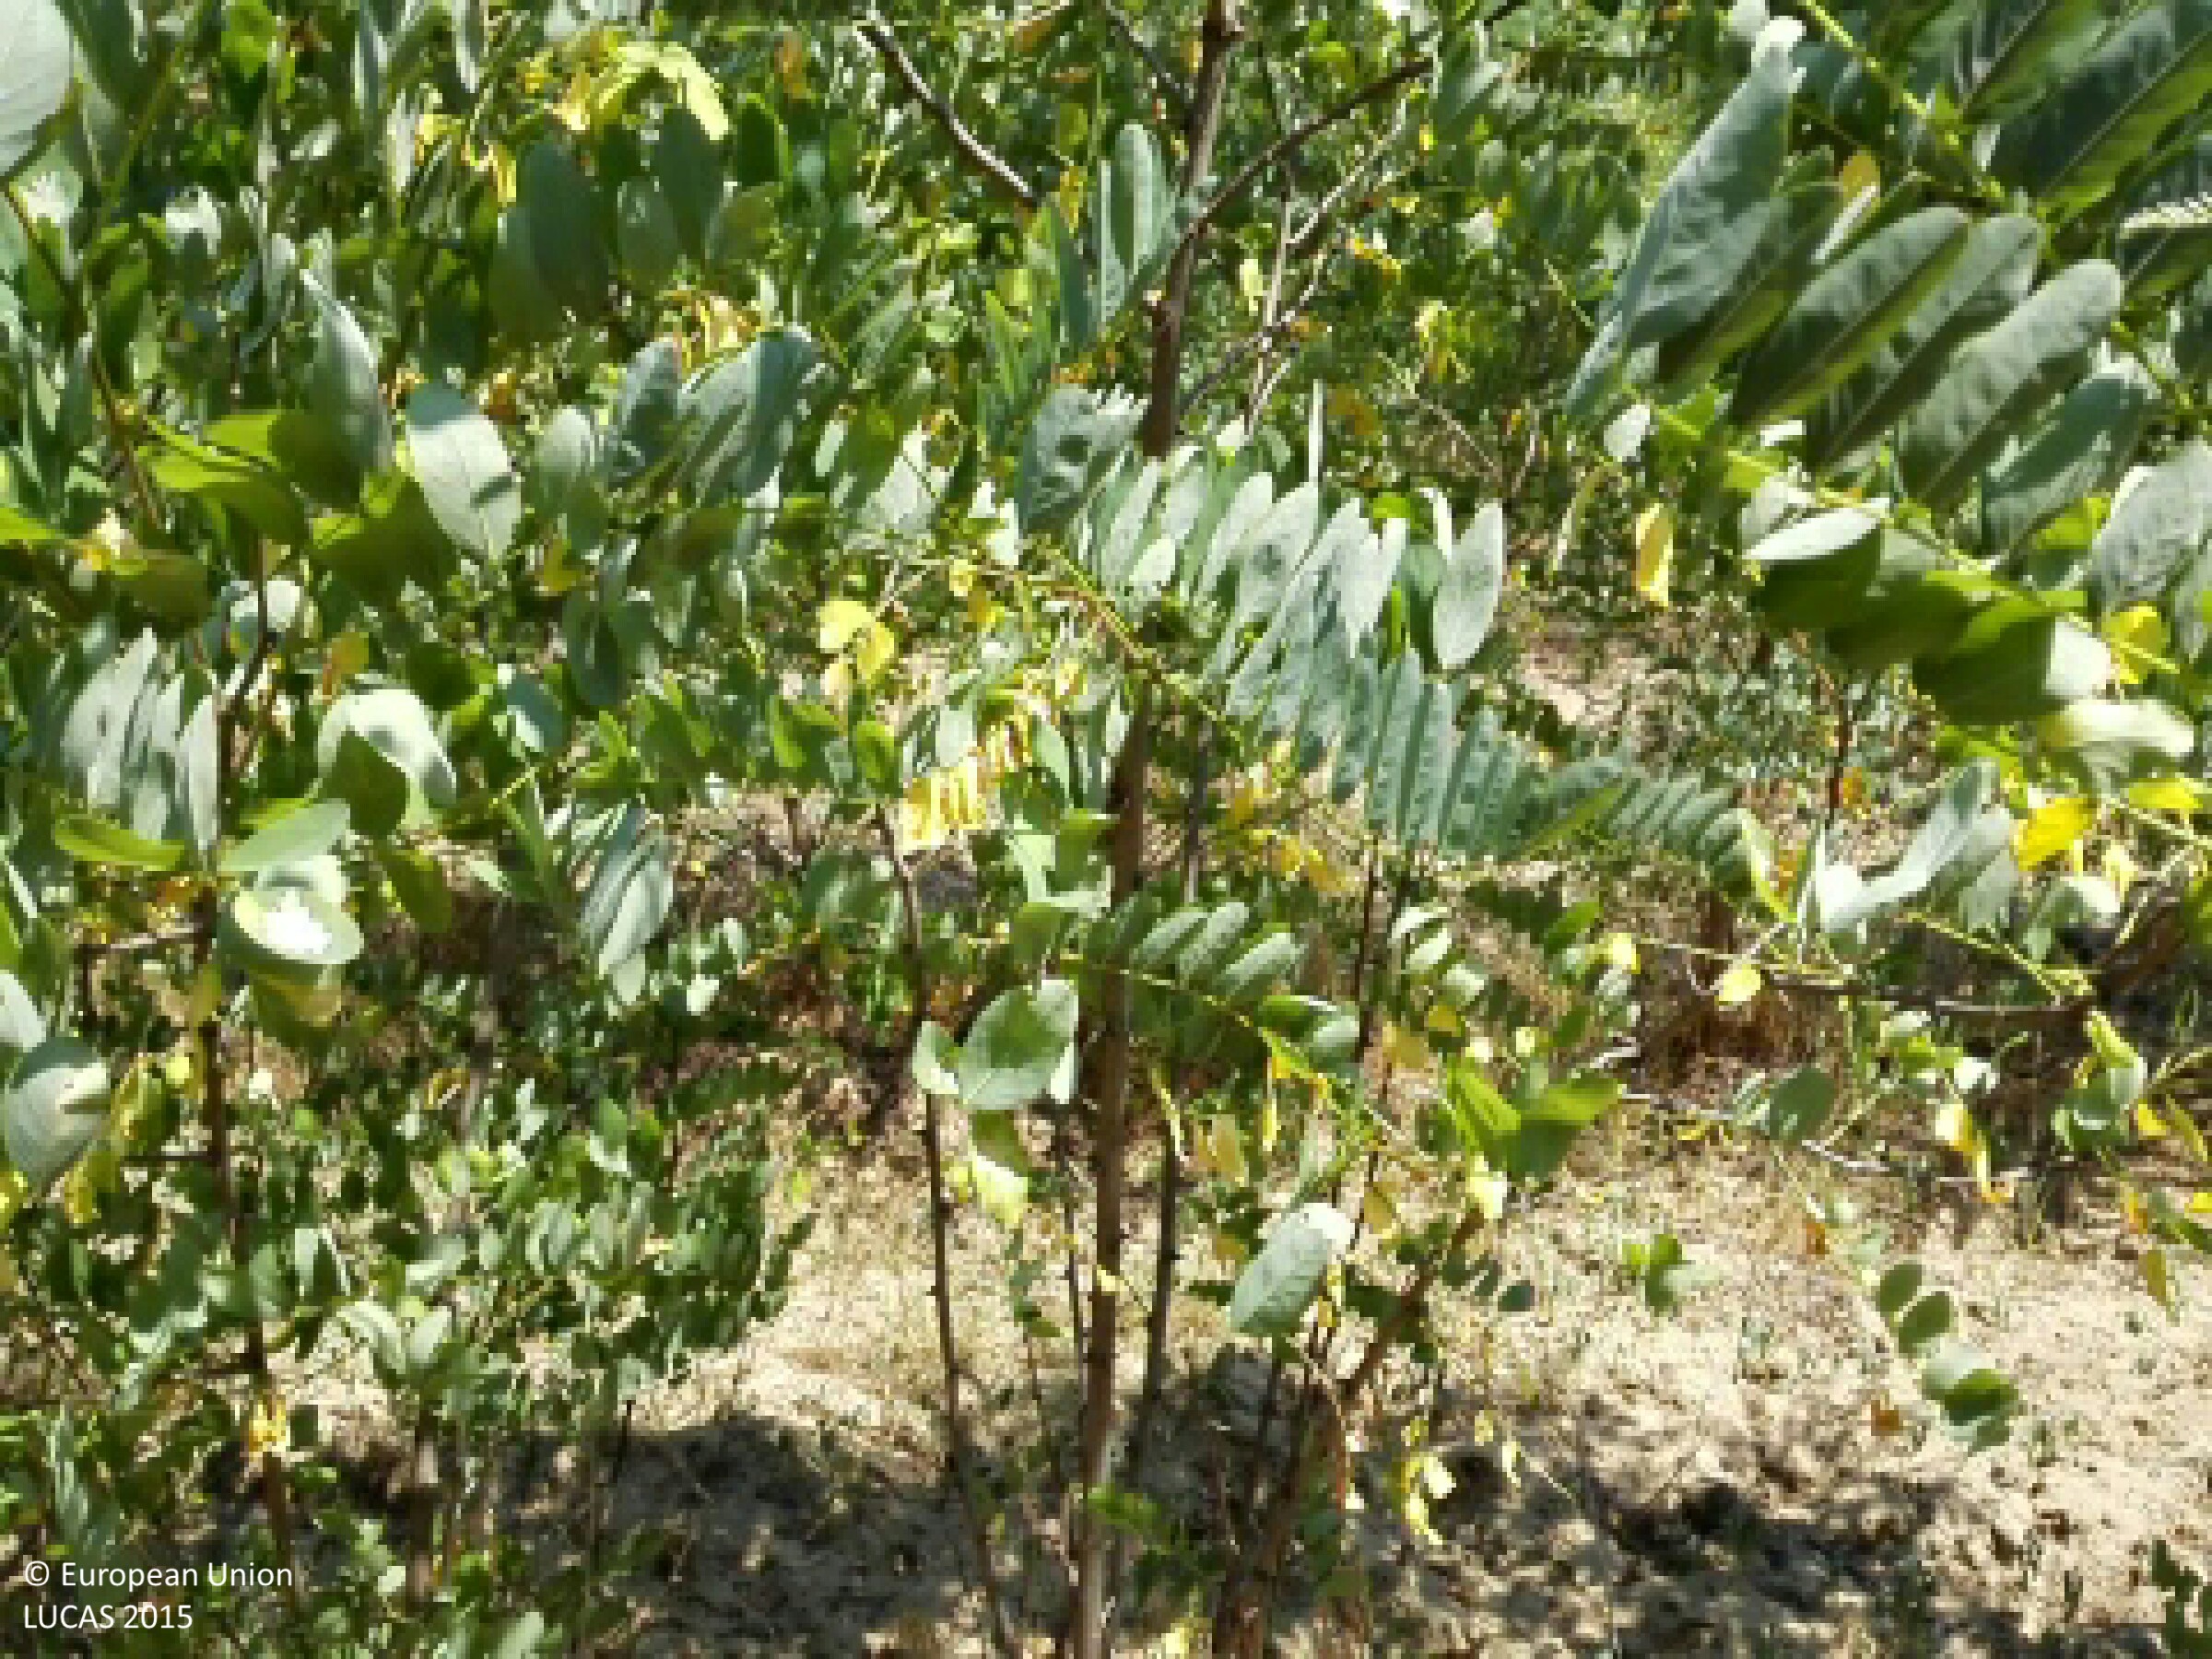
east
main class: Woodland
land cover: Broadleaved woodland
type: thermophilous deciduous forest
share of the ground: > 75 %
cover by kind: broadleaved forest trees 100 %
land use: Forestry
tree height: < 5 m
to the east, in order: Broadleaved woodland; Shrubland with sparse tree cover; Ditches and canals; Railways; Shrubland with sparse tree cover; Maize
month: July
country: HU
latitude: 47.6205
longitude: 21.6613
